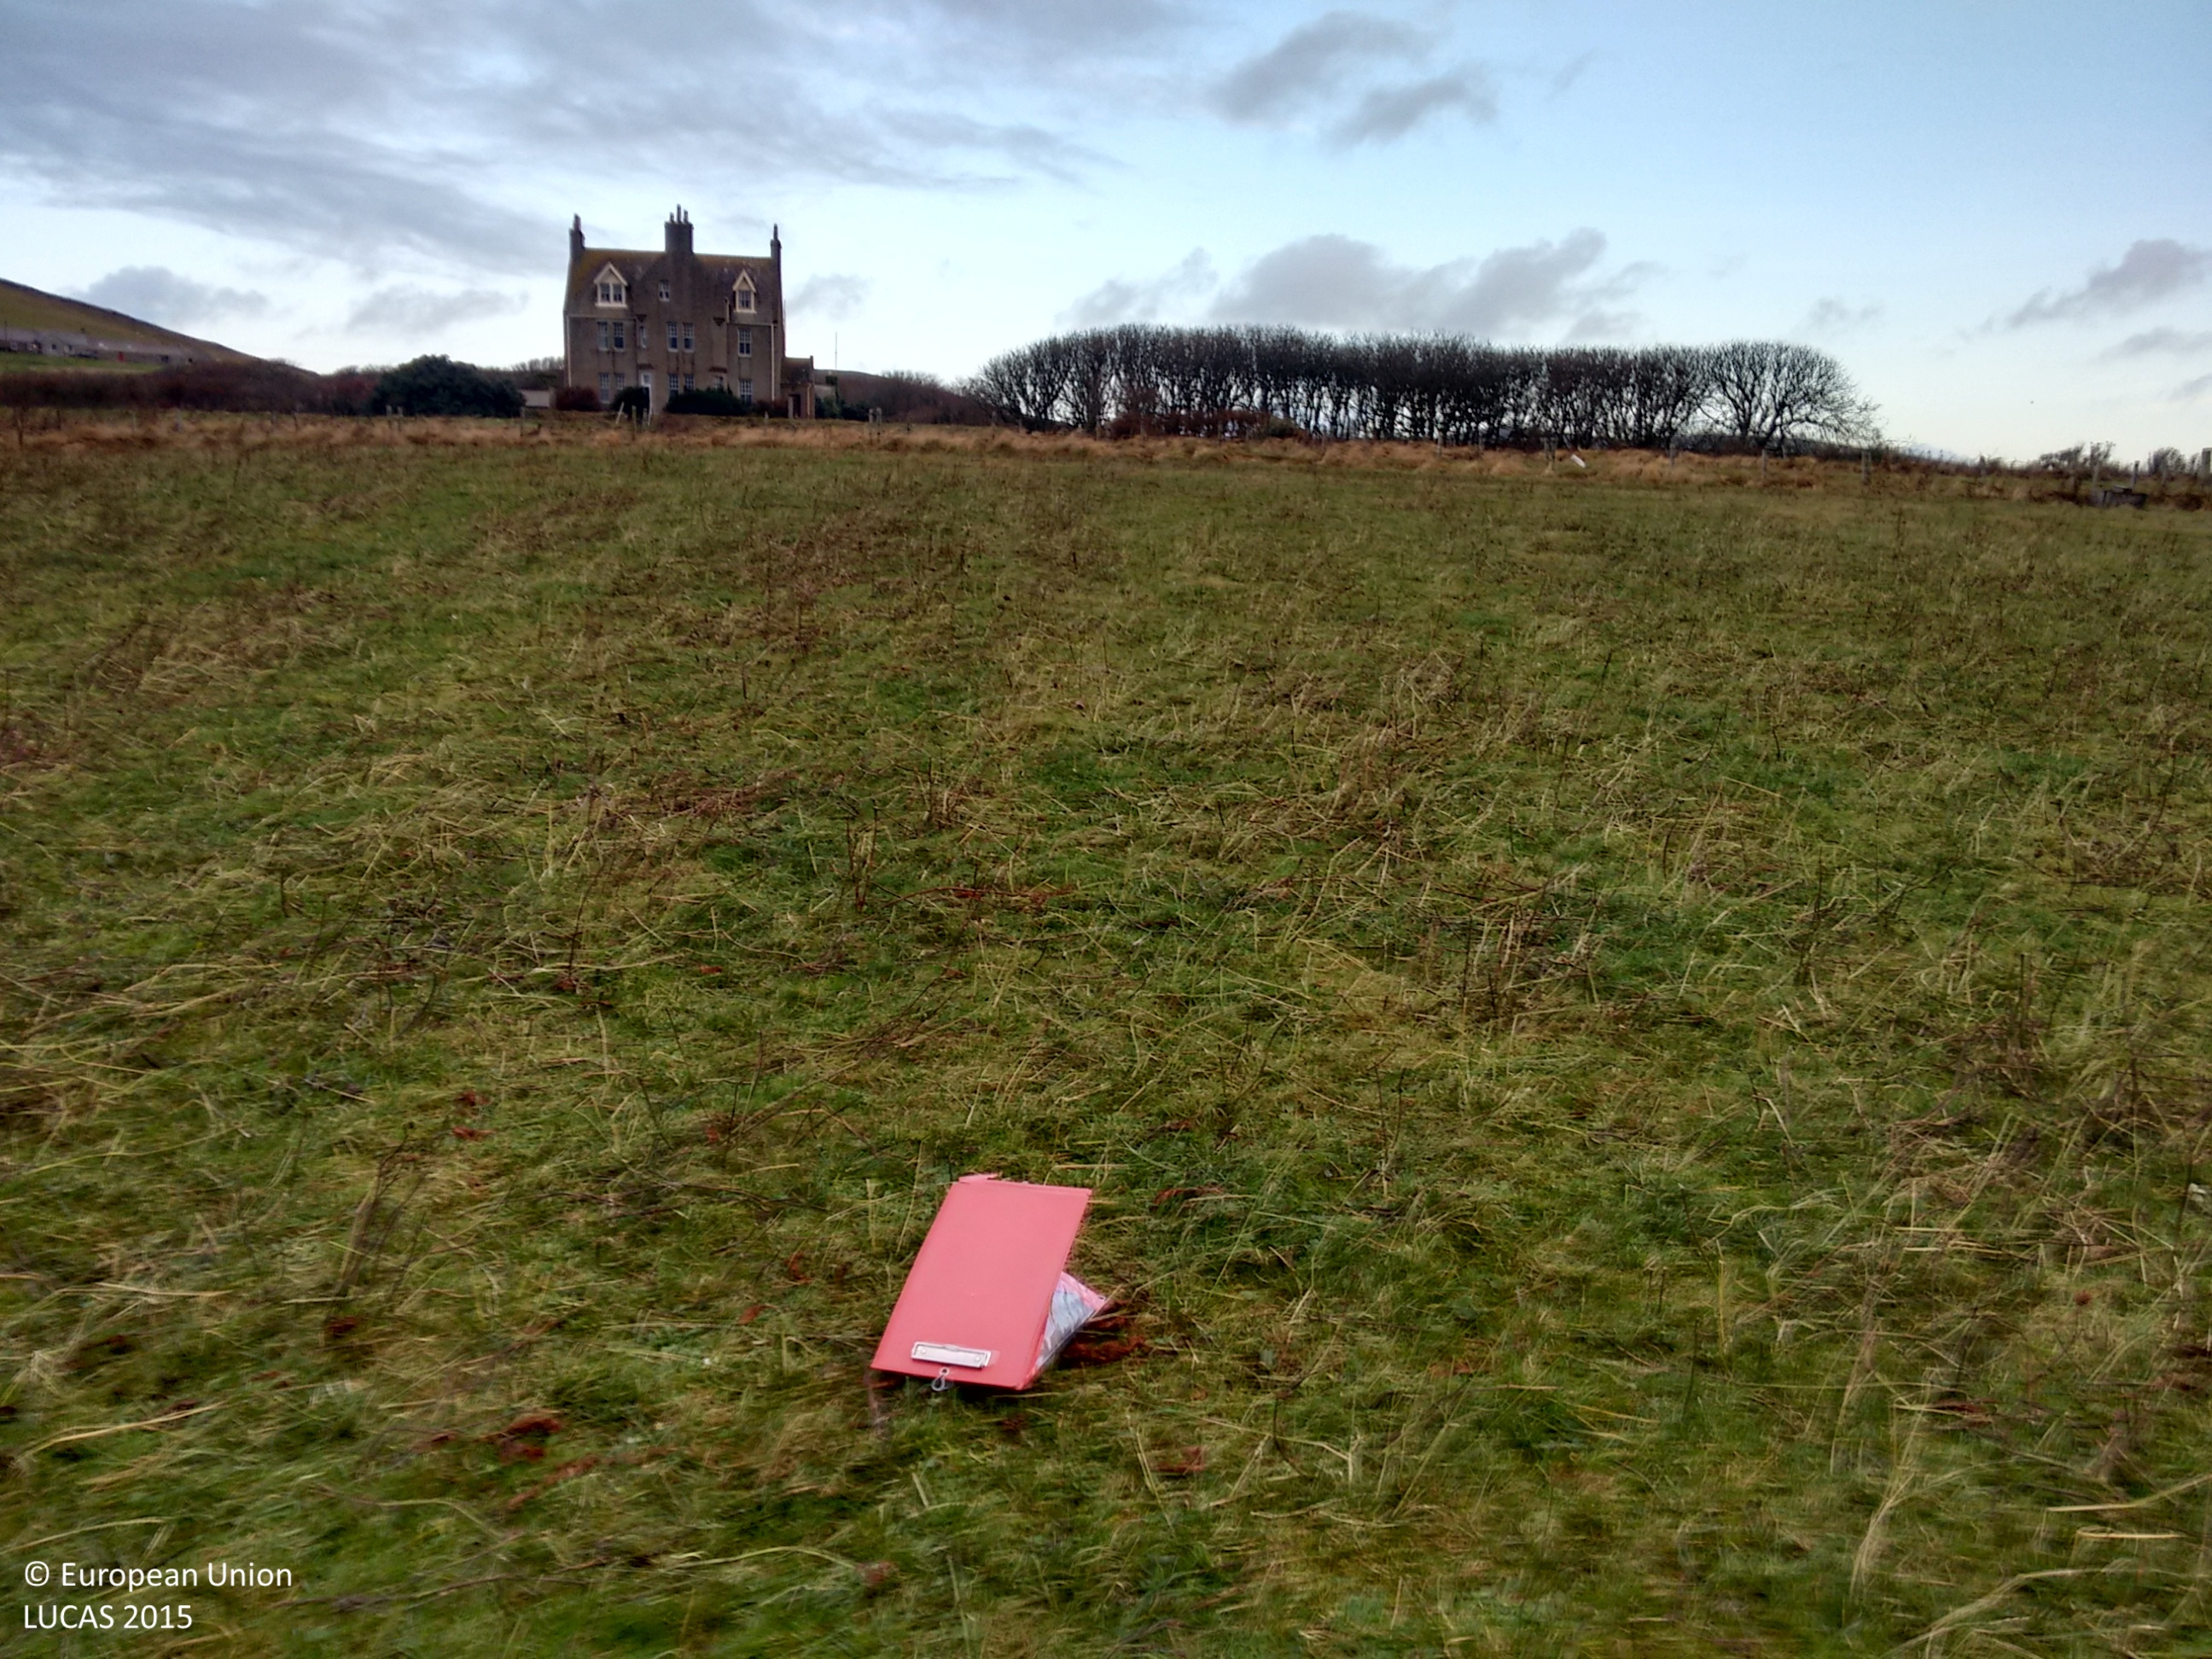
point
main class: Grassland
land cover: Grassland without tree/shrub cover
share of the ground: > 75 %
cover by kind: herbaceous plants 100 %
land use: Agriculture (excluding fallow land and kitchen gardens)
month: November
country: GB
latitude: 58.9198
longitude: -3.1680
